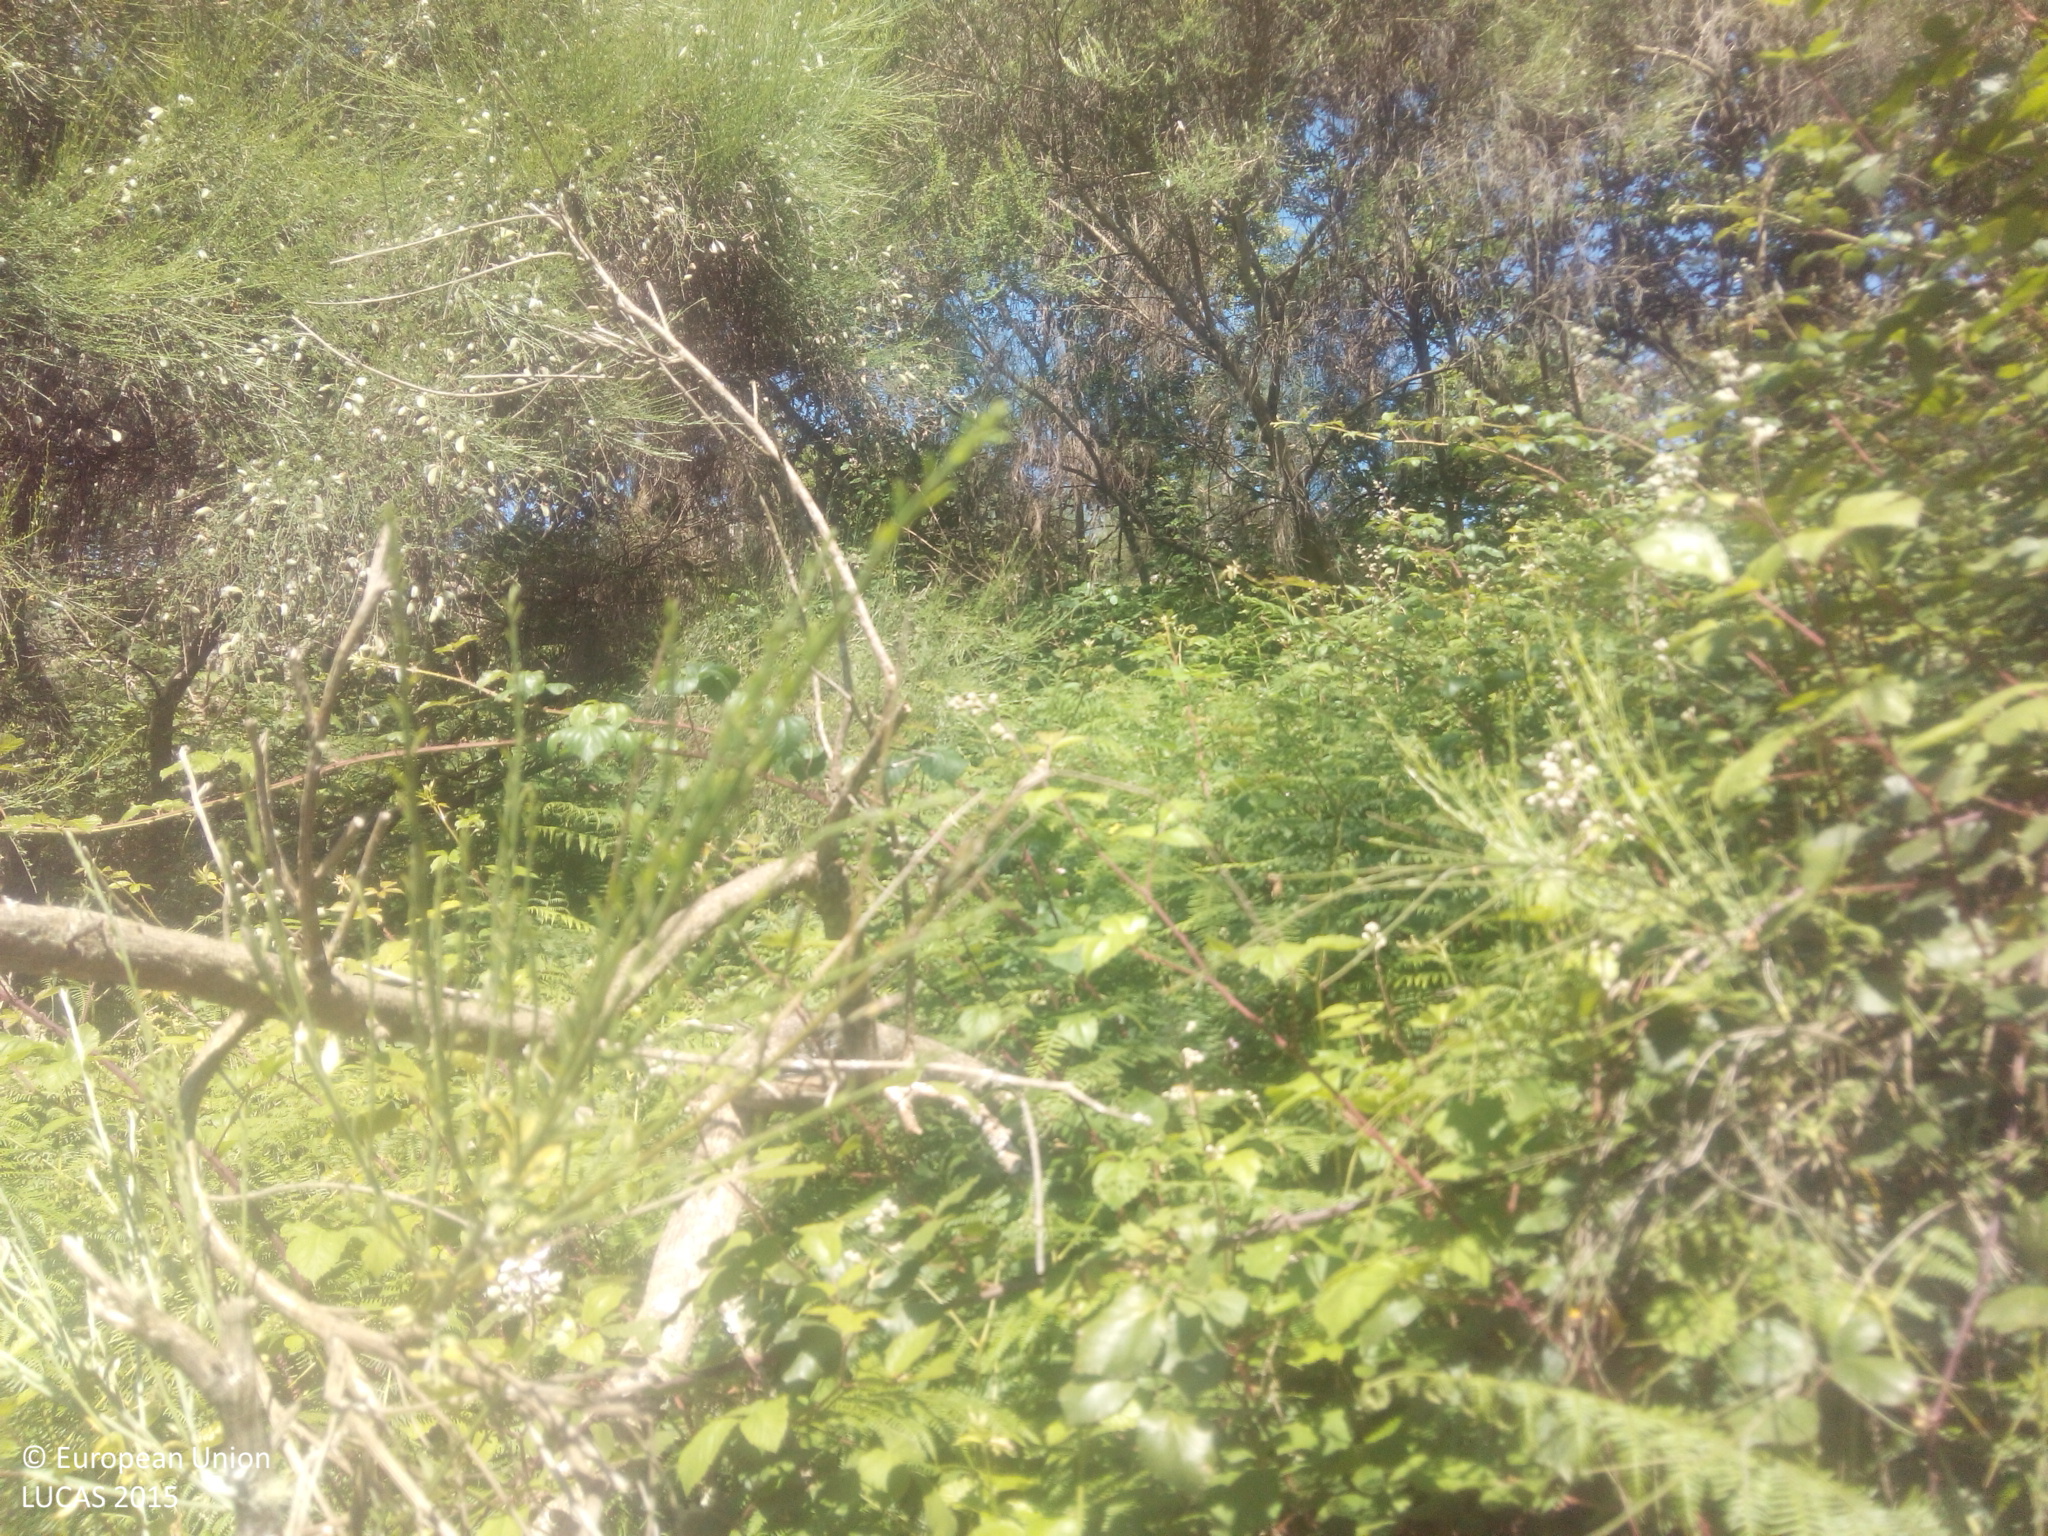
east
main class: Woodland
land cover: Broadleaved woodland
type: thermophilous deciduous forest
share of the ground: > 75 %
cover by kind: shrubs 75 %, broadleaved forest trees 20 %, coniferous forest trees 5 %
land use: Forestry
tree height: > 5 m
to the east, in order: Broadleaved woodland; Dry stone walls; Tracks; Artificial constructions; Fences; Grassland without tree/shrub cover; Broadleaved woodland; Shrubland without tree cover; Dry stone walls; Tracks; Fences; Shrubland without tree cover; Rock outcrops; Shrubland without tree cover
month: June
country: ES
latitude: 42.4357
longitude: -8.3637
